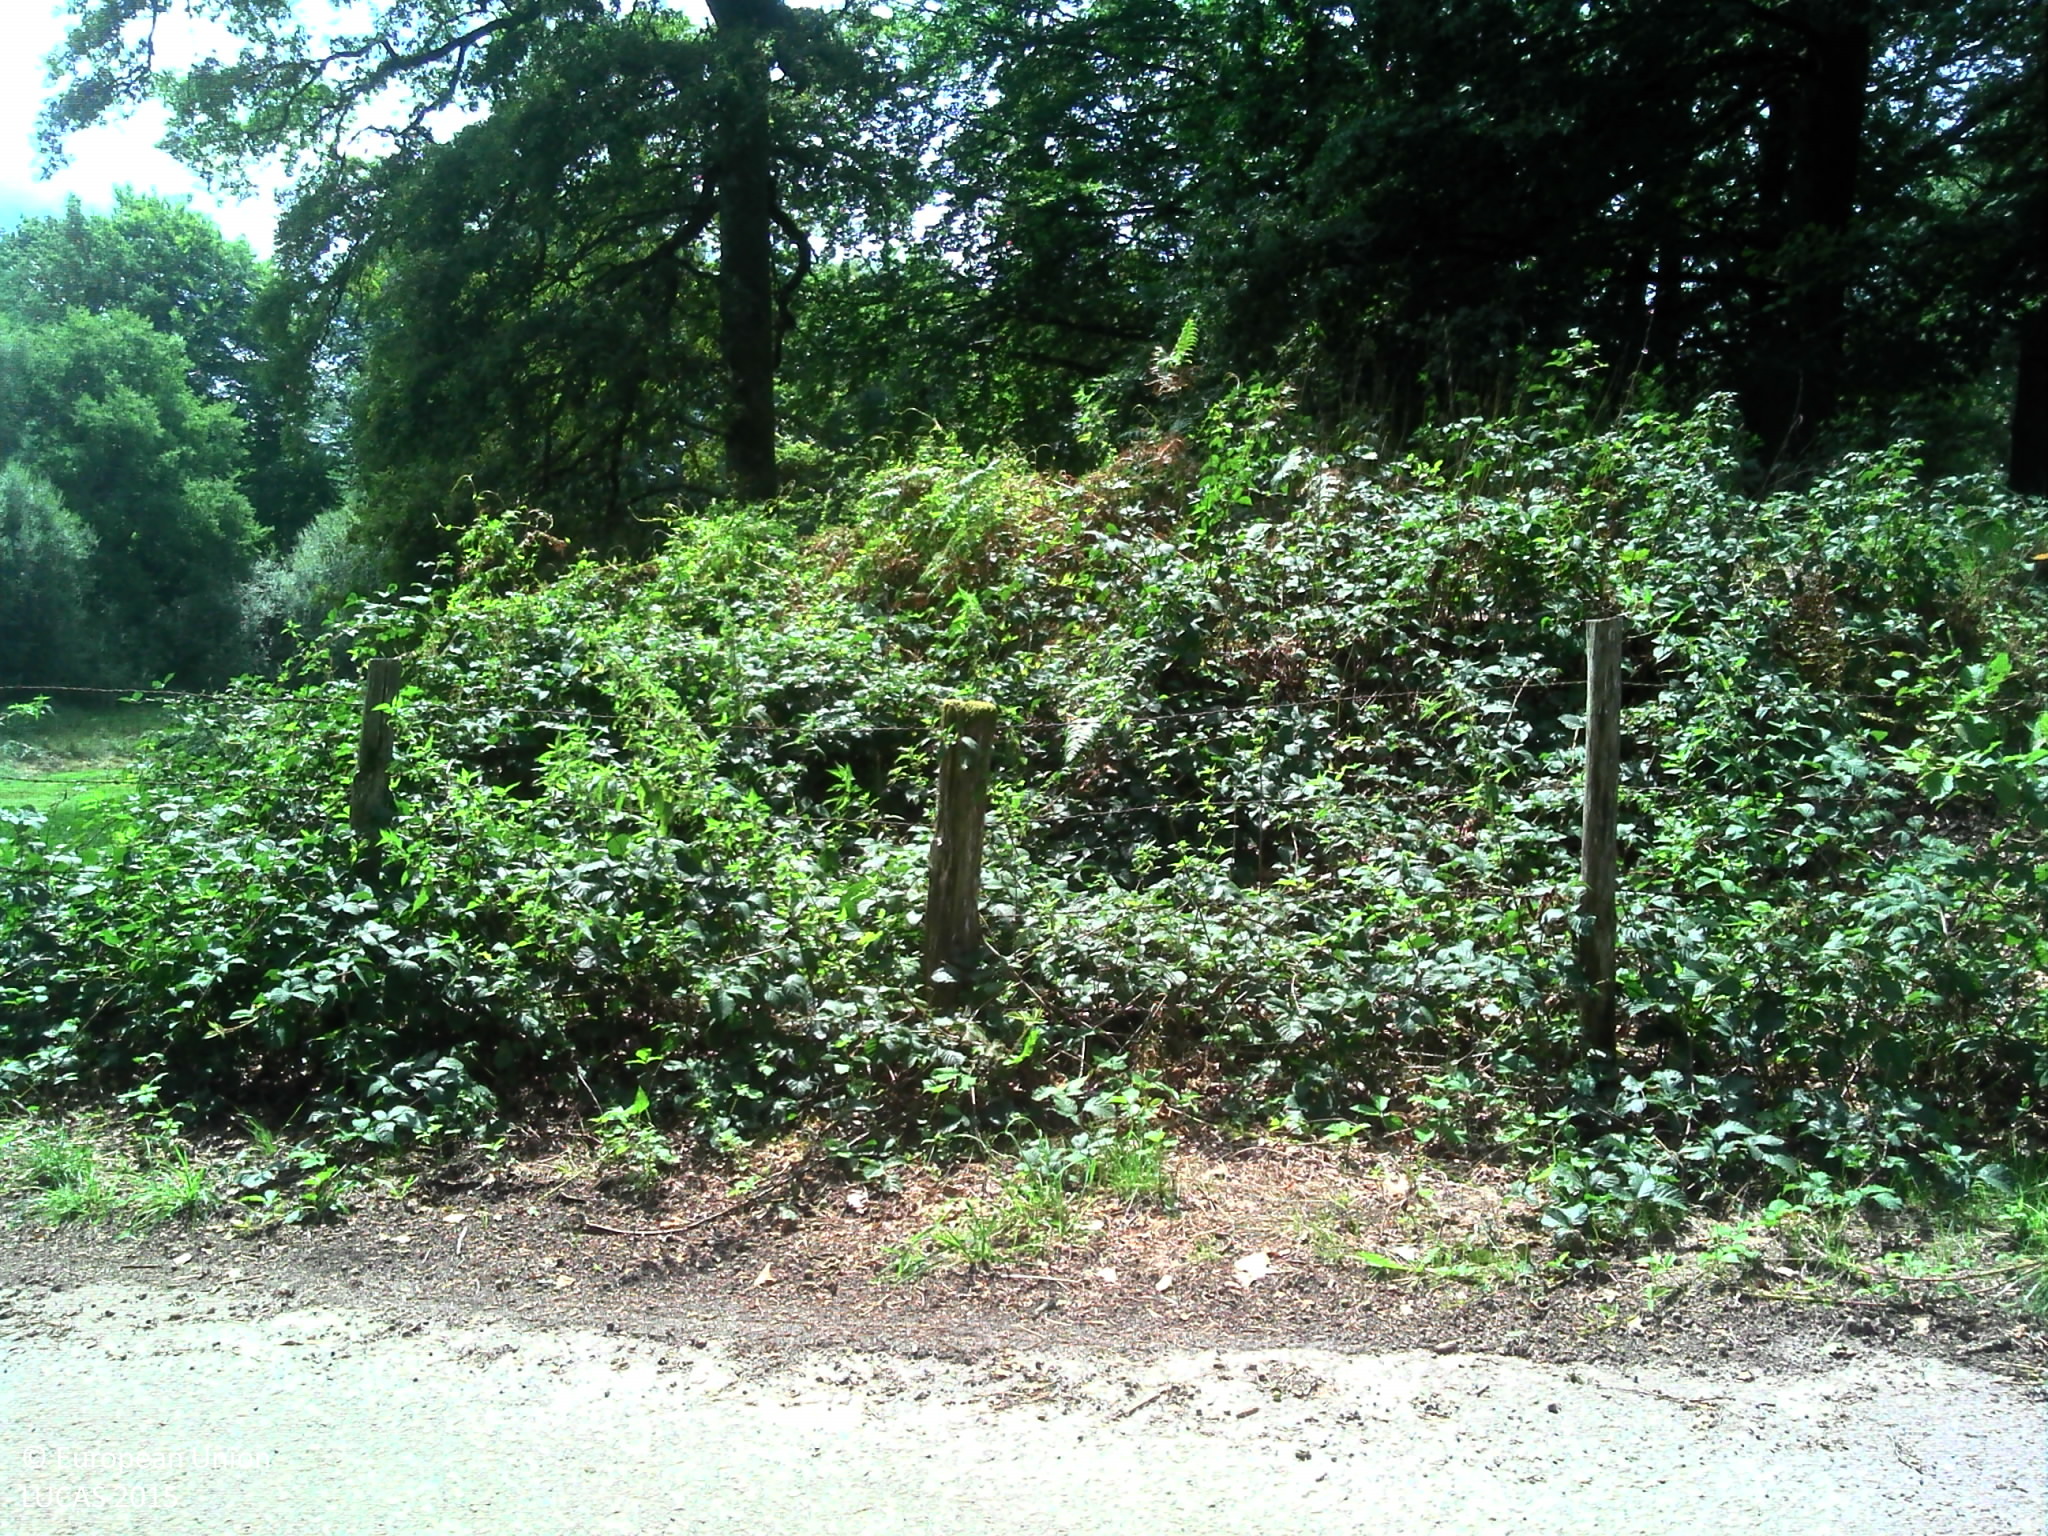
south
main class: Grassland
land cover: Spontaneously vegetated surfaces
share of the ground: > 75 %
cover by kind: herbaceous plants 95 %, shrubs 5 %
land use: Semi-natural and natural areas not in use
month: August
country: FR
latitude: 45.8323
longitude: 1.7417
